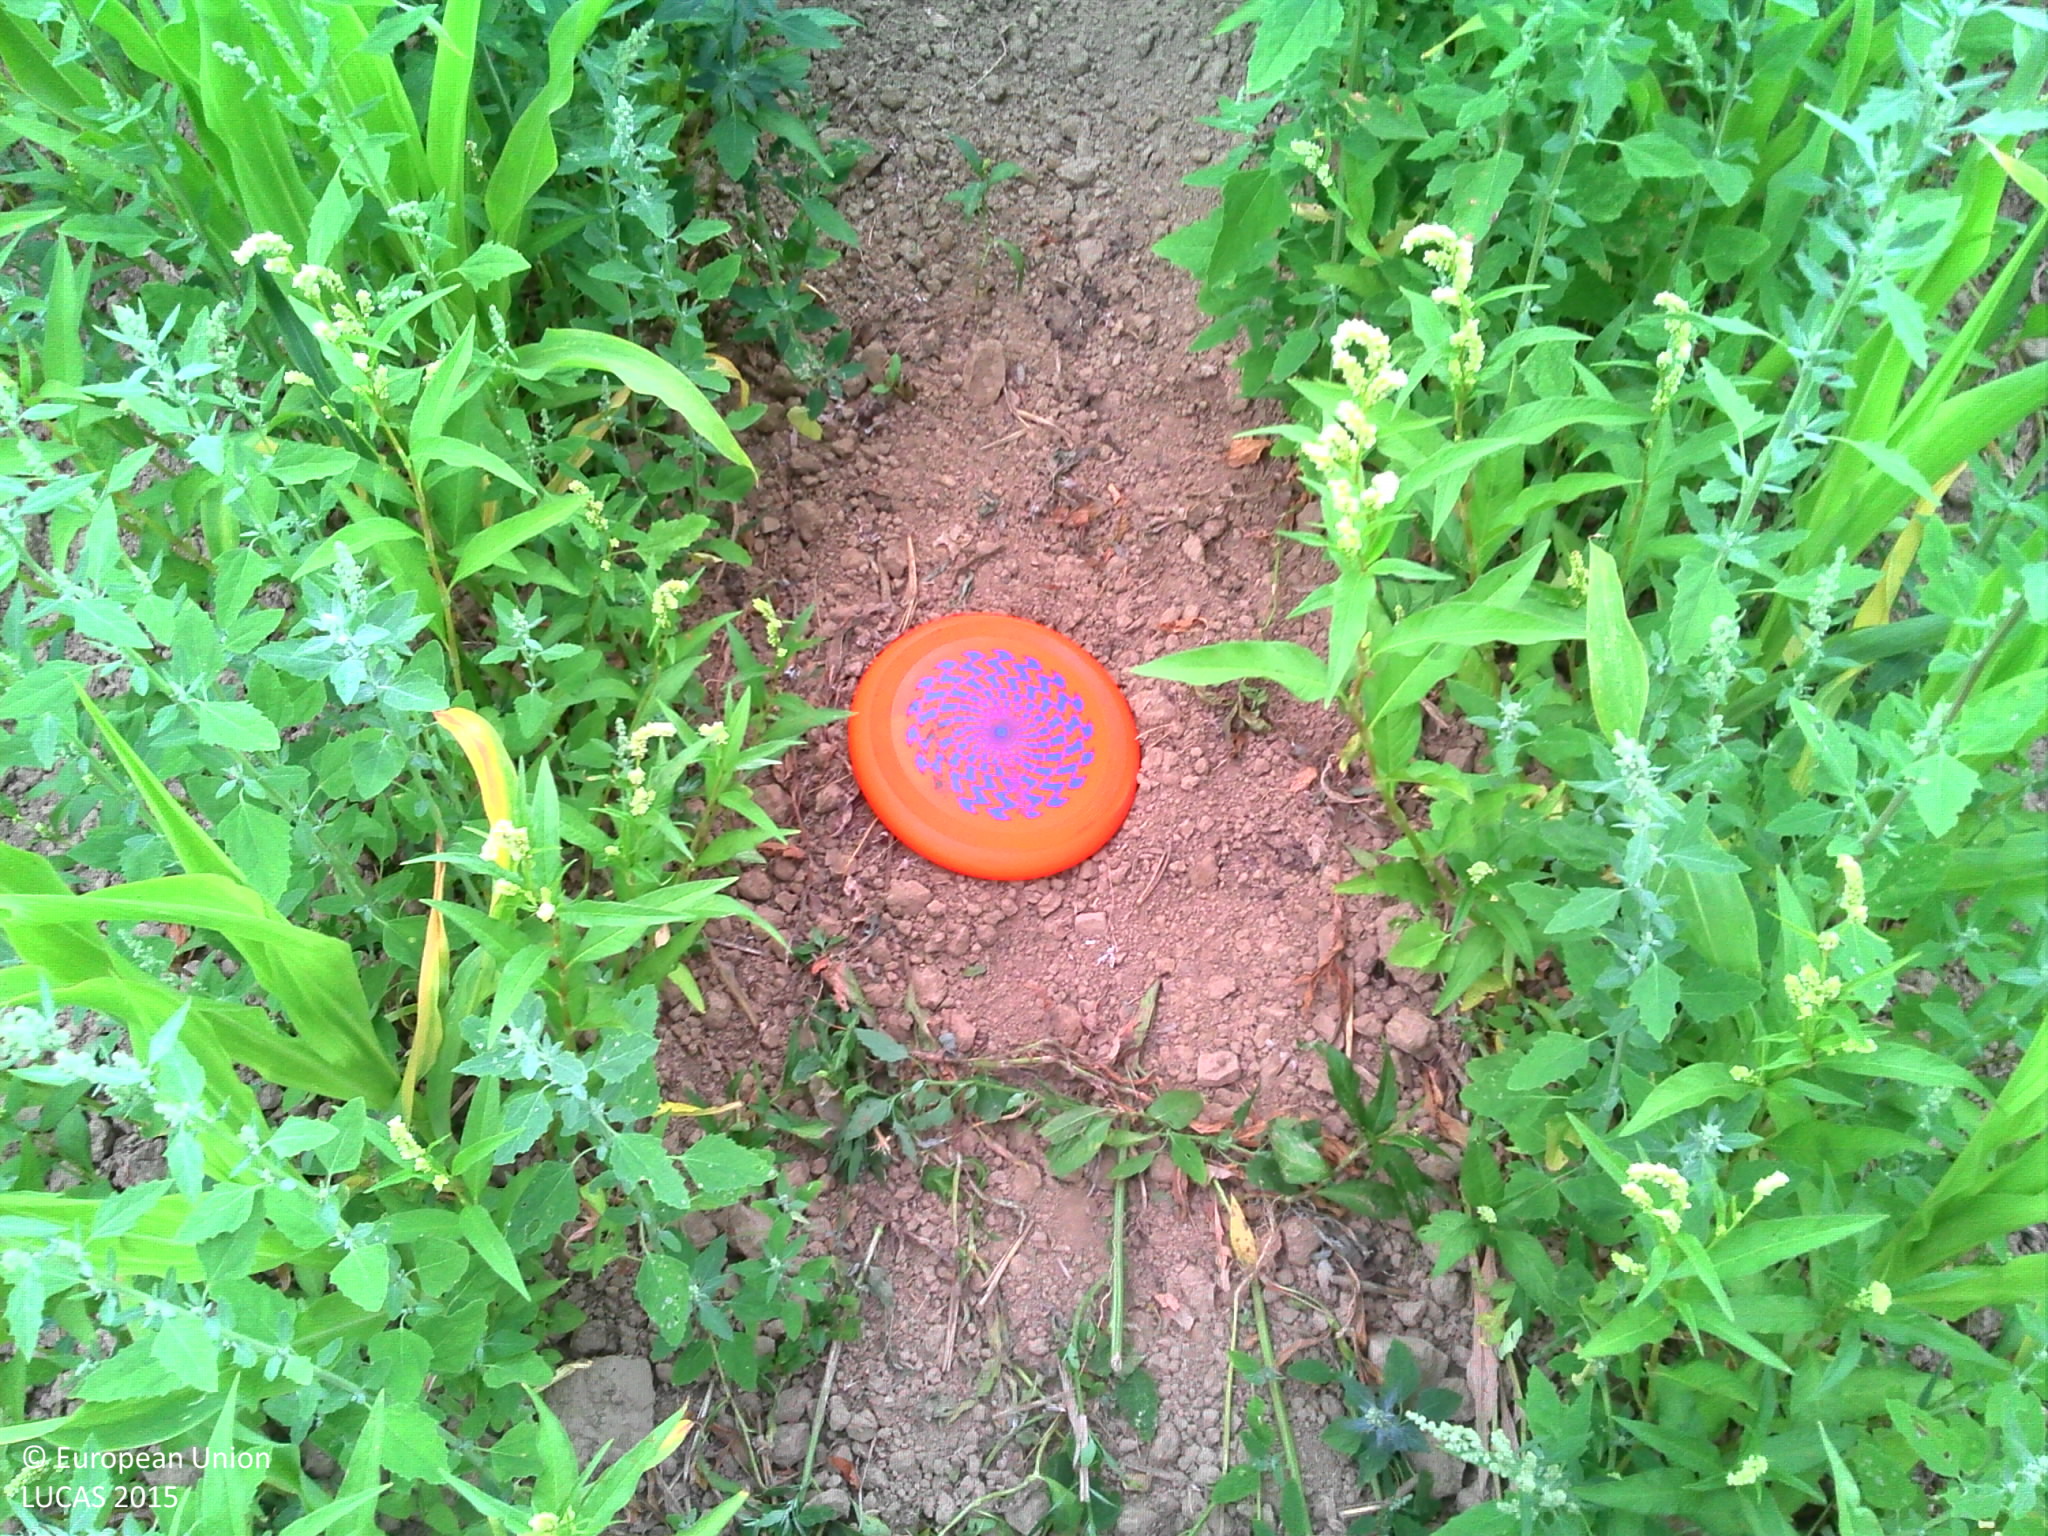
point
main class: Cropland
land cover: Maize
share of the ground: > 75 %
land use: Agriculture (excluding fallow land and kitchen gardens)
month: July
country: FR
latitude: 48.3865
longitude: -0.1722
